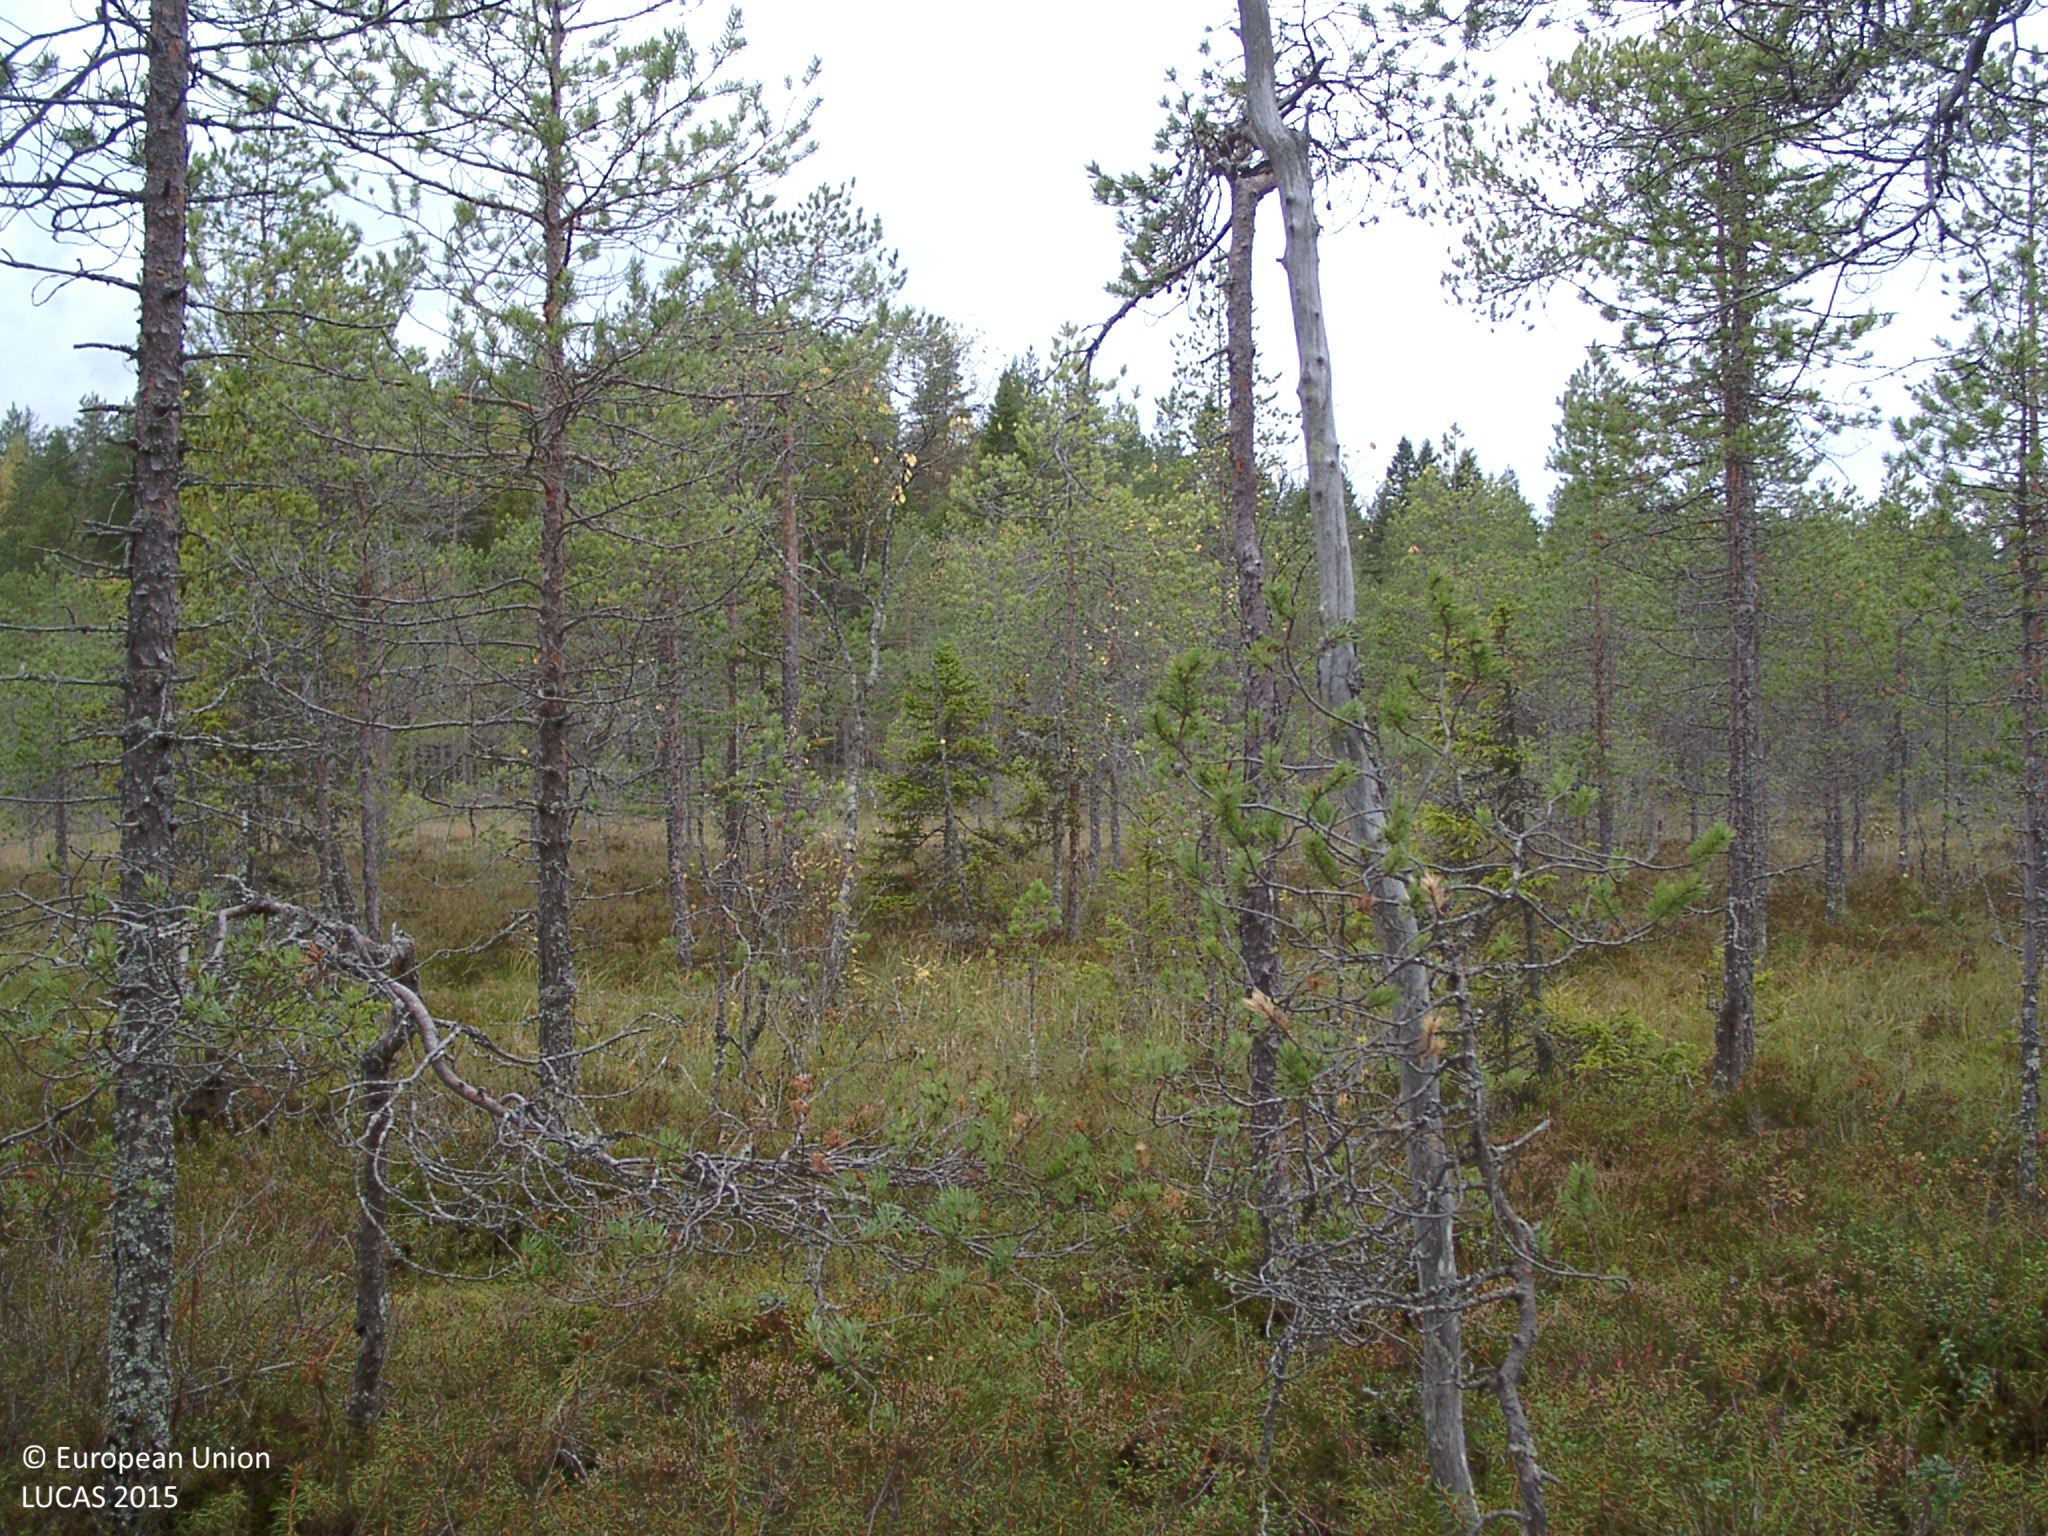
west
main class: Woodland
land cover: Pine dominated coniferous woodland
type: mire and swamp forests
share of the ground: 10 - 25 %
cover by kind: shrubs 60 %, coniferous forest trees 20 %, lichens and mosses 15 %, herbaceous plants 5 %
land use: Amenities, museums, leisure
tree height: < 5 m
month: September
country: FI
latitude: 62.8414
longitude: 25.4437
